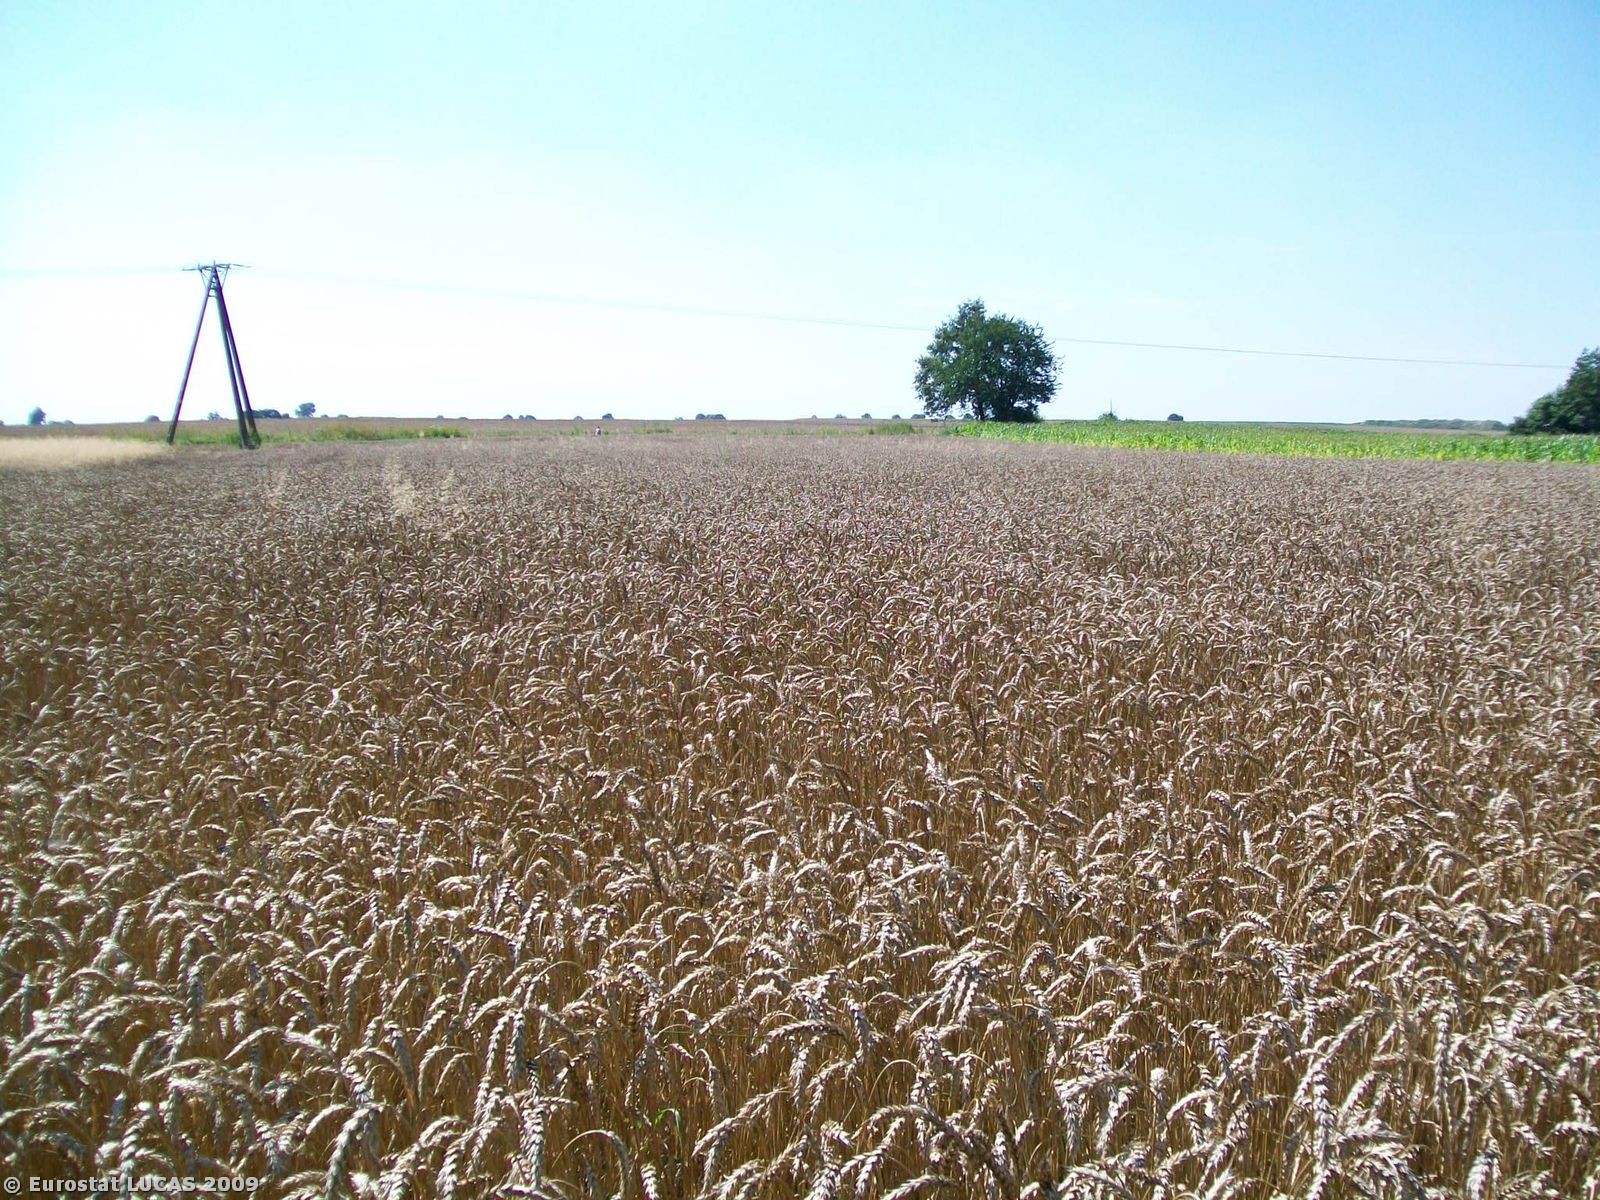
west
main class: Cropland
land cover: Common wheat
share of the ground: > 75 %
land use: Agriculture (excluding fallow land and kitchen gardens)
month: August
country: PL
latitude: 51.0484
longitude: 16.7561
